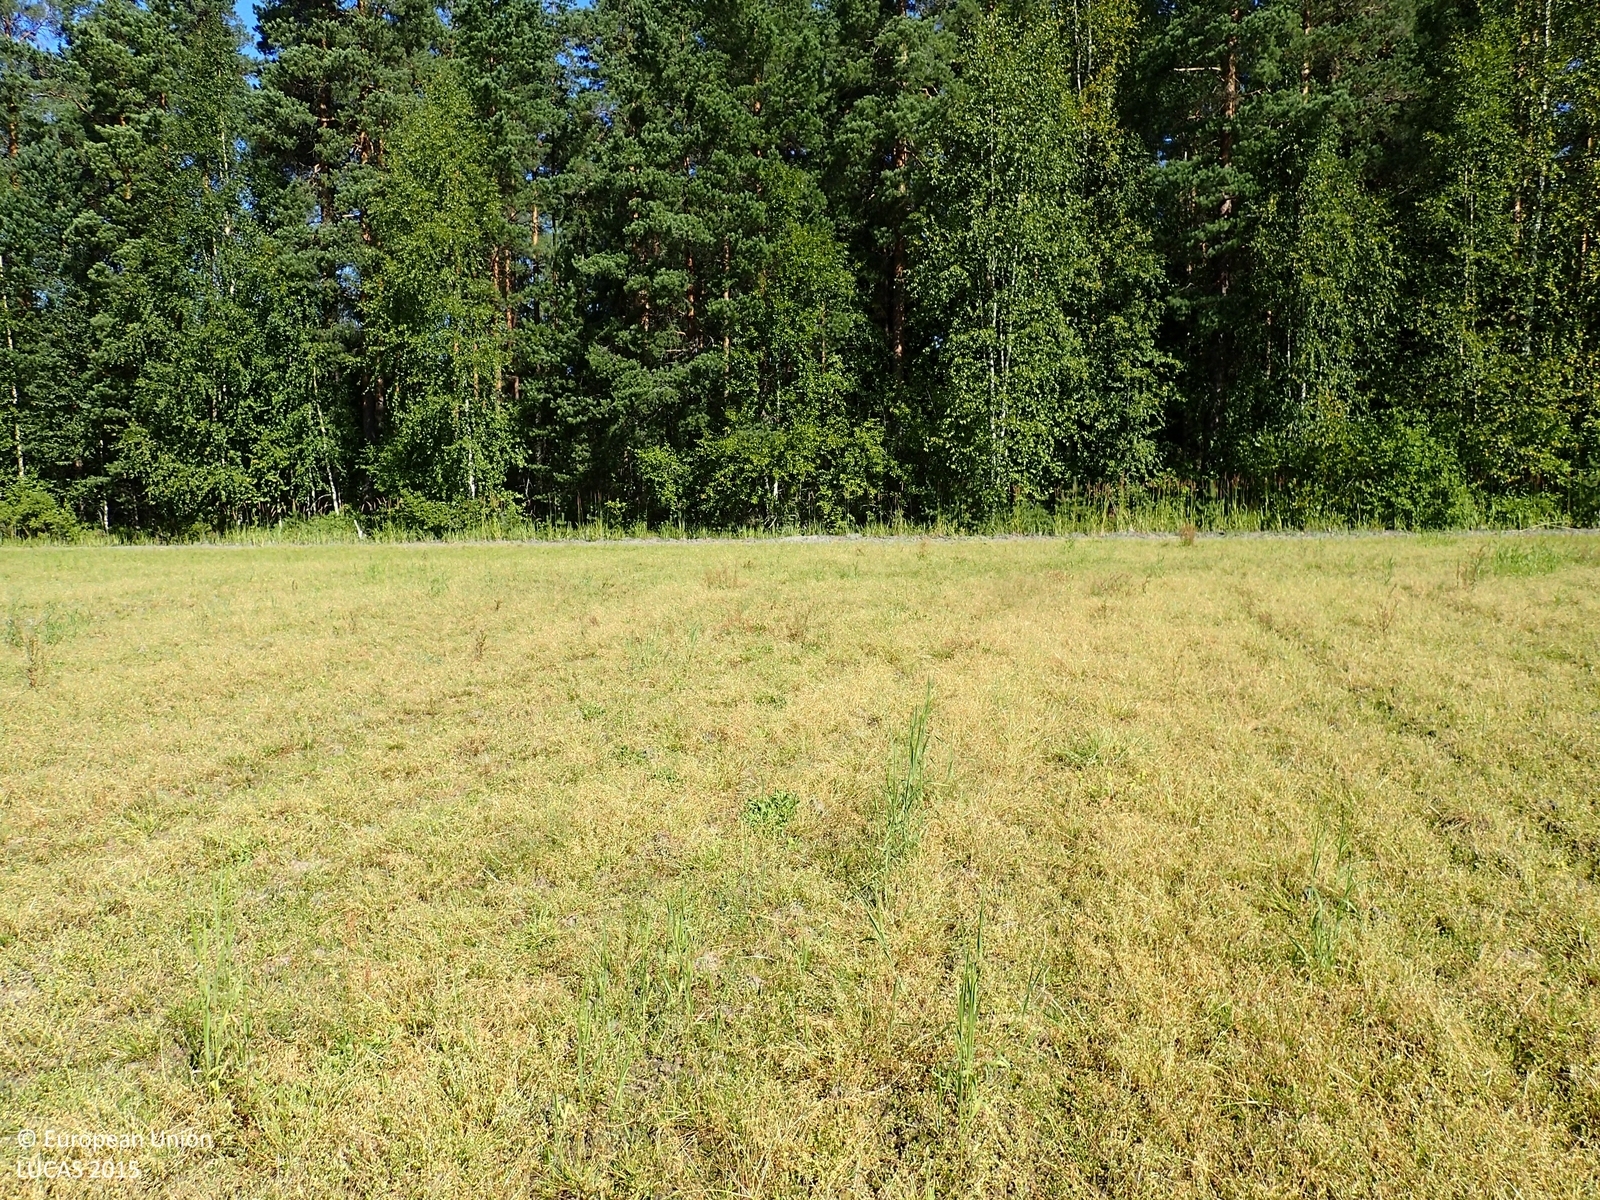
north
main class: Grassland
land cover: Spontaneously vegetated surfaces
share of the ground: > 75 %
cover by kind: herbaceous plants 100 %
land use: Agriculture (excluding fallow land and kitchen gardens)
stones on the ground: < 10 %
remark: Harvested field
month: August
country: FI
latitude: 62.5078
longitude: 22.3055
